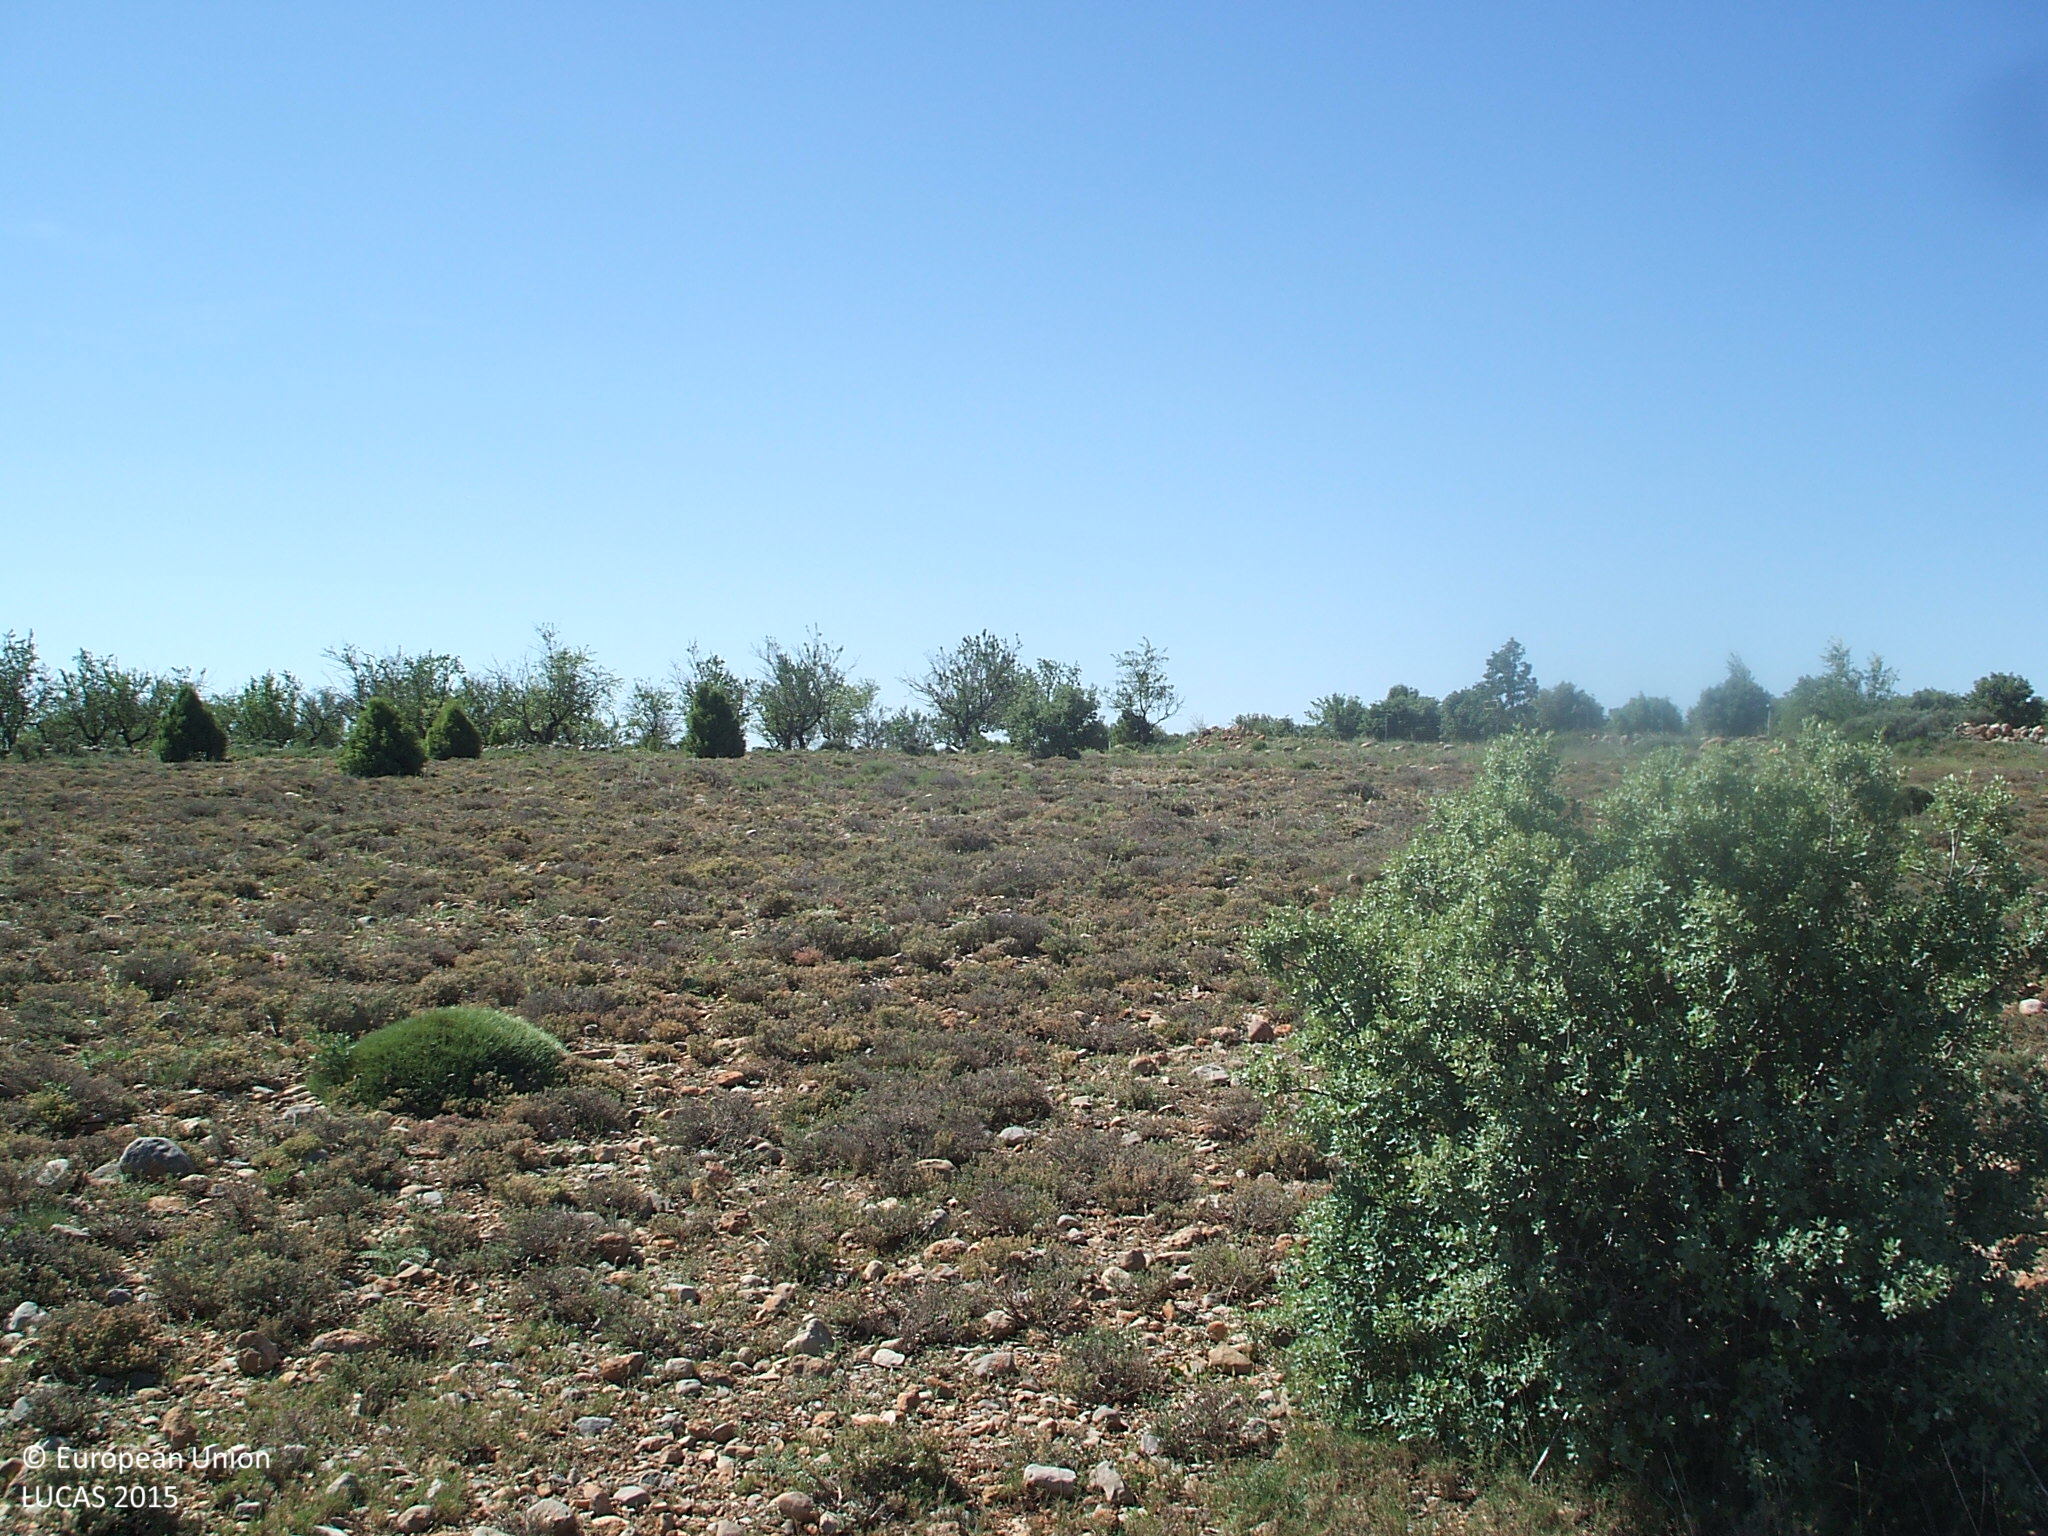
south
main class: Shrubland
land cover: Shrubland without tree cover
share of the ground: 50 - 75 %
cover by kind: consolidated bare surface 60 %, shrubs 20 %, herbaceous plants 20 %
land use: Abandoned areas
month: May
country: ES
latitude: 40.0931
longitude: -0.7615
